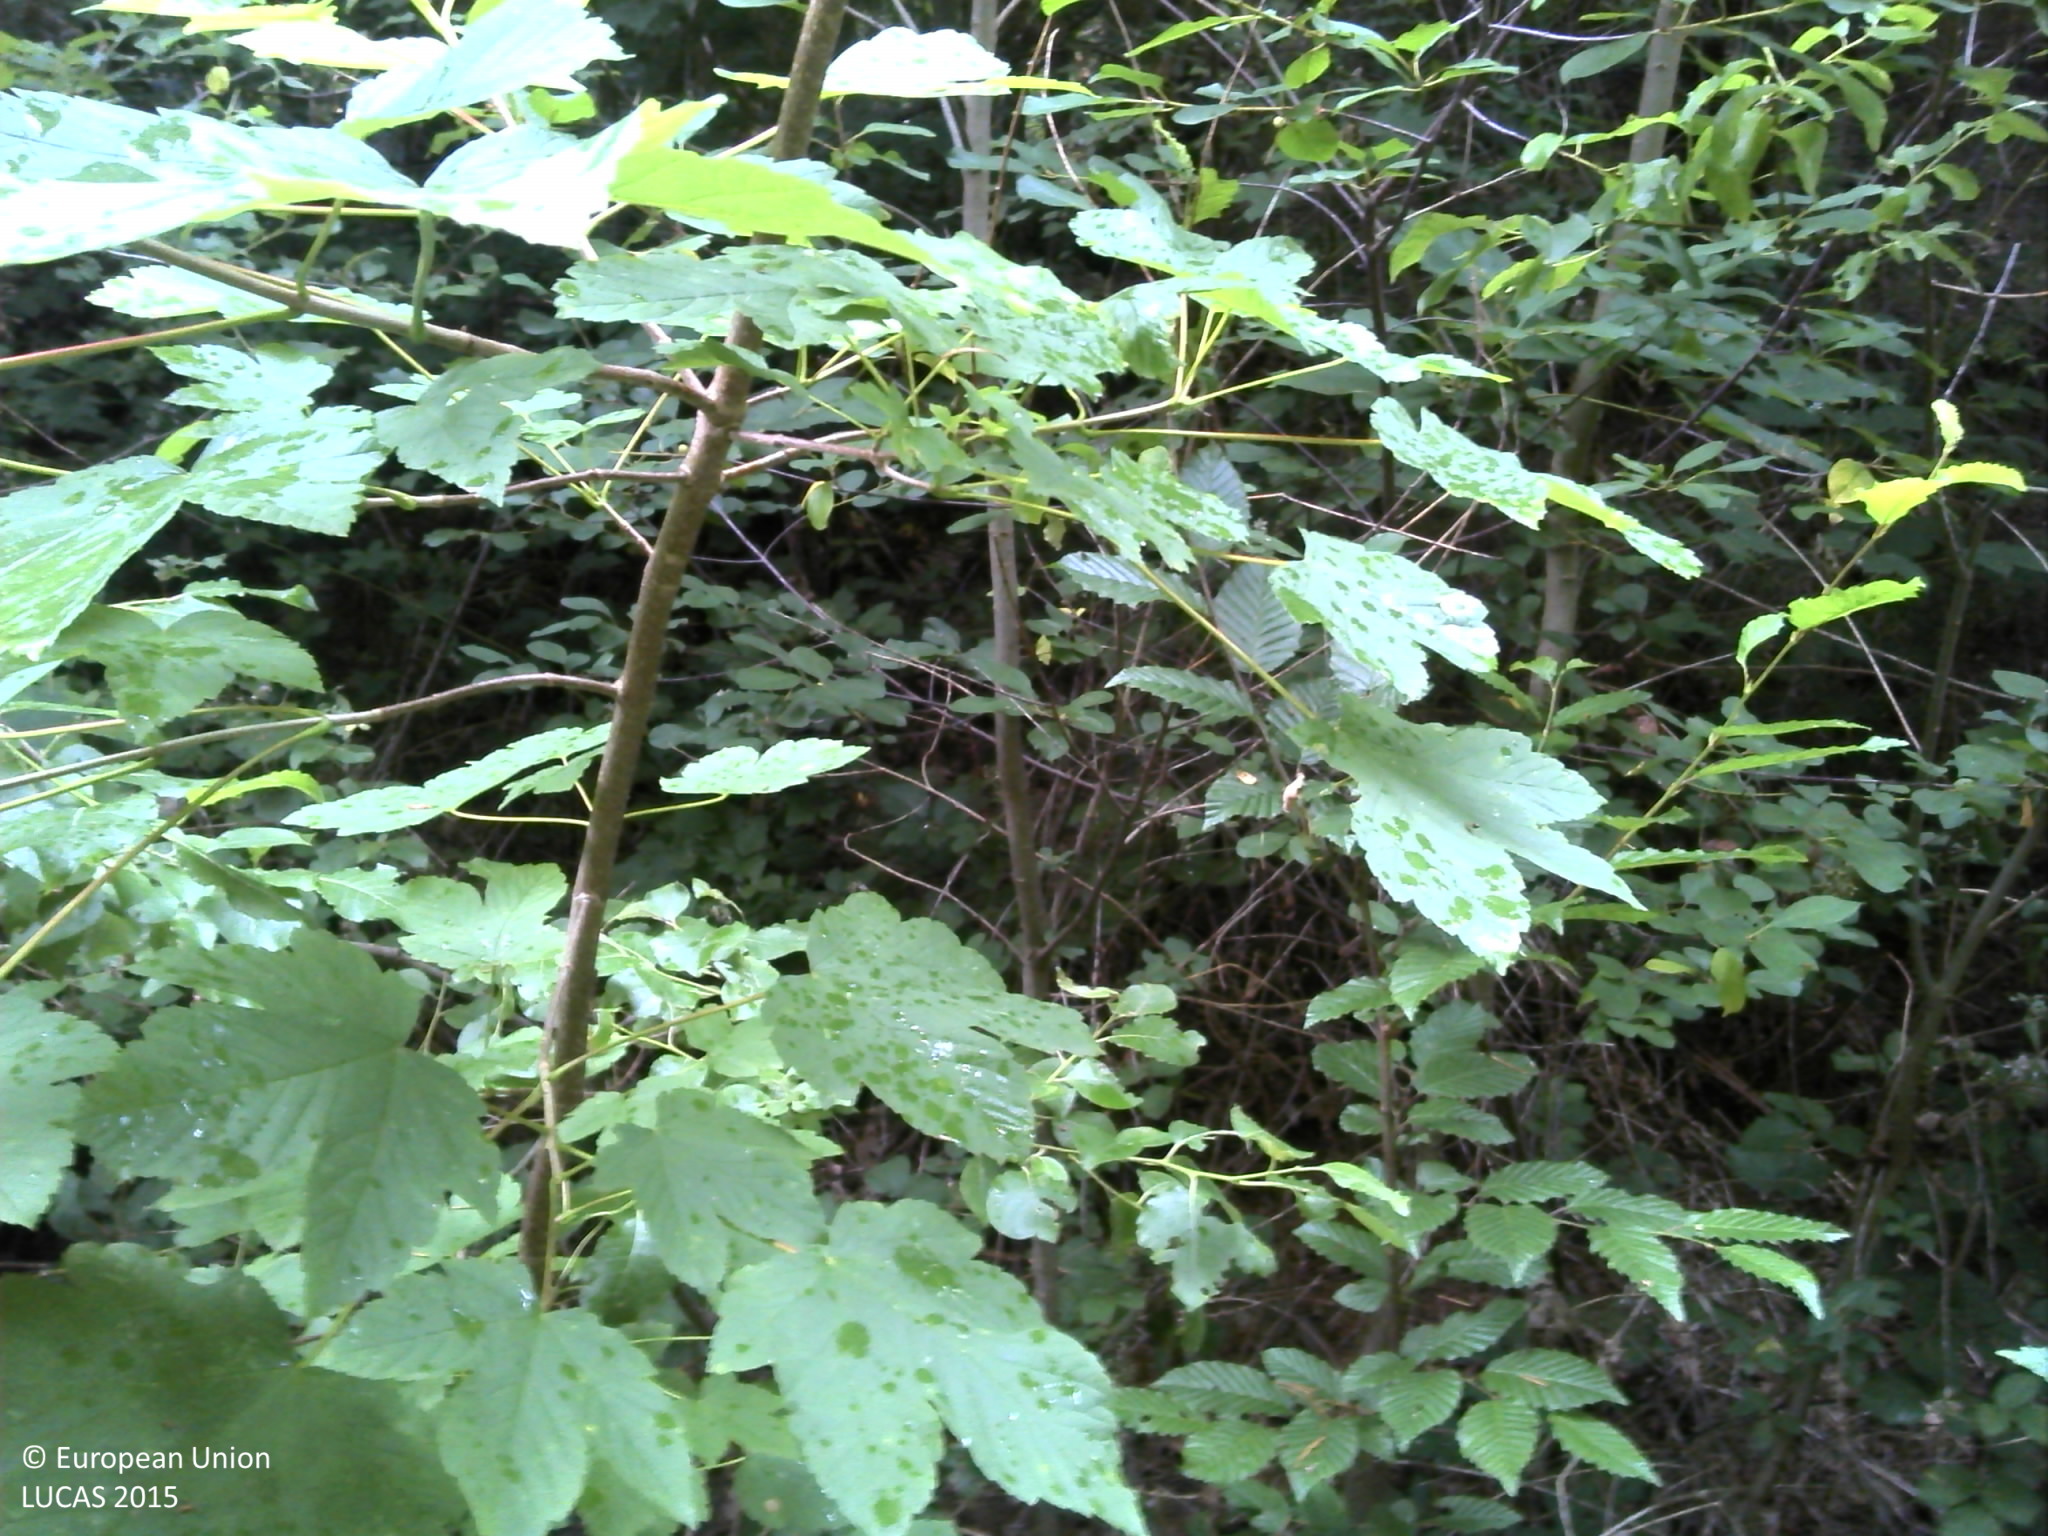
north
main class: Woodland
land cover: Broadleaved woodland
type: mesophytic deciduous forest
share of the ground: > 75 %
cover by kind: broadleaved forest trees 70 %, herbaceous plants 25 %, consolidated bare surface 5 %
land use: Forestry
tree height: > 5 m
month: July
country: FR
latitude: 49.8319
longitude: 4.8113
